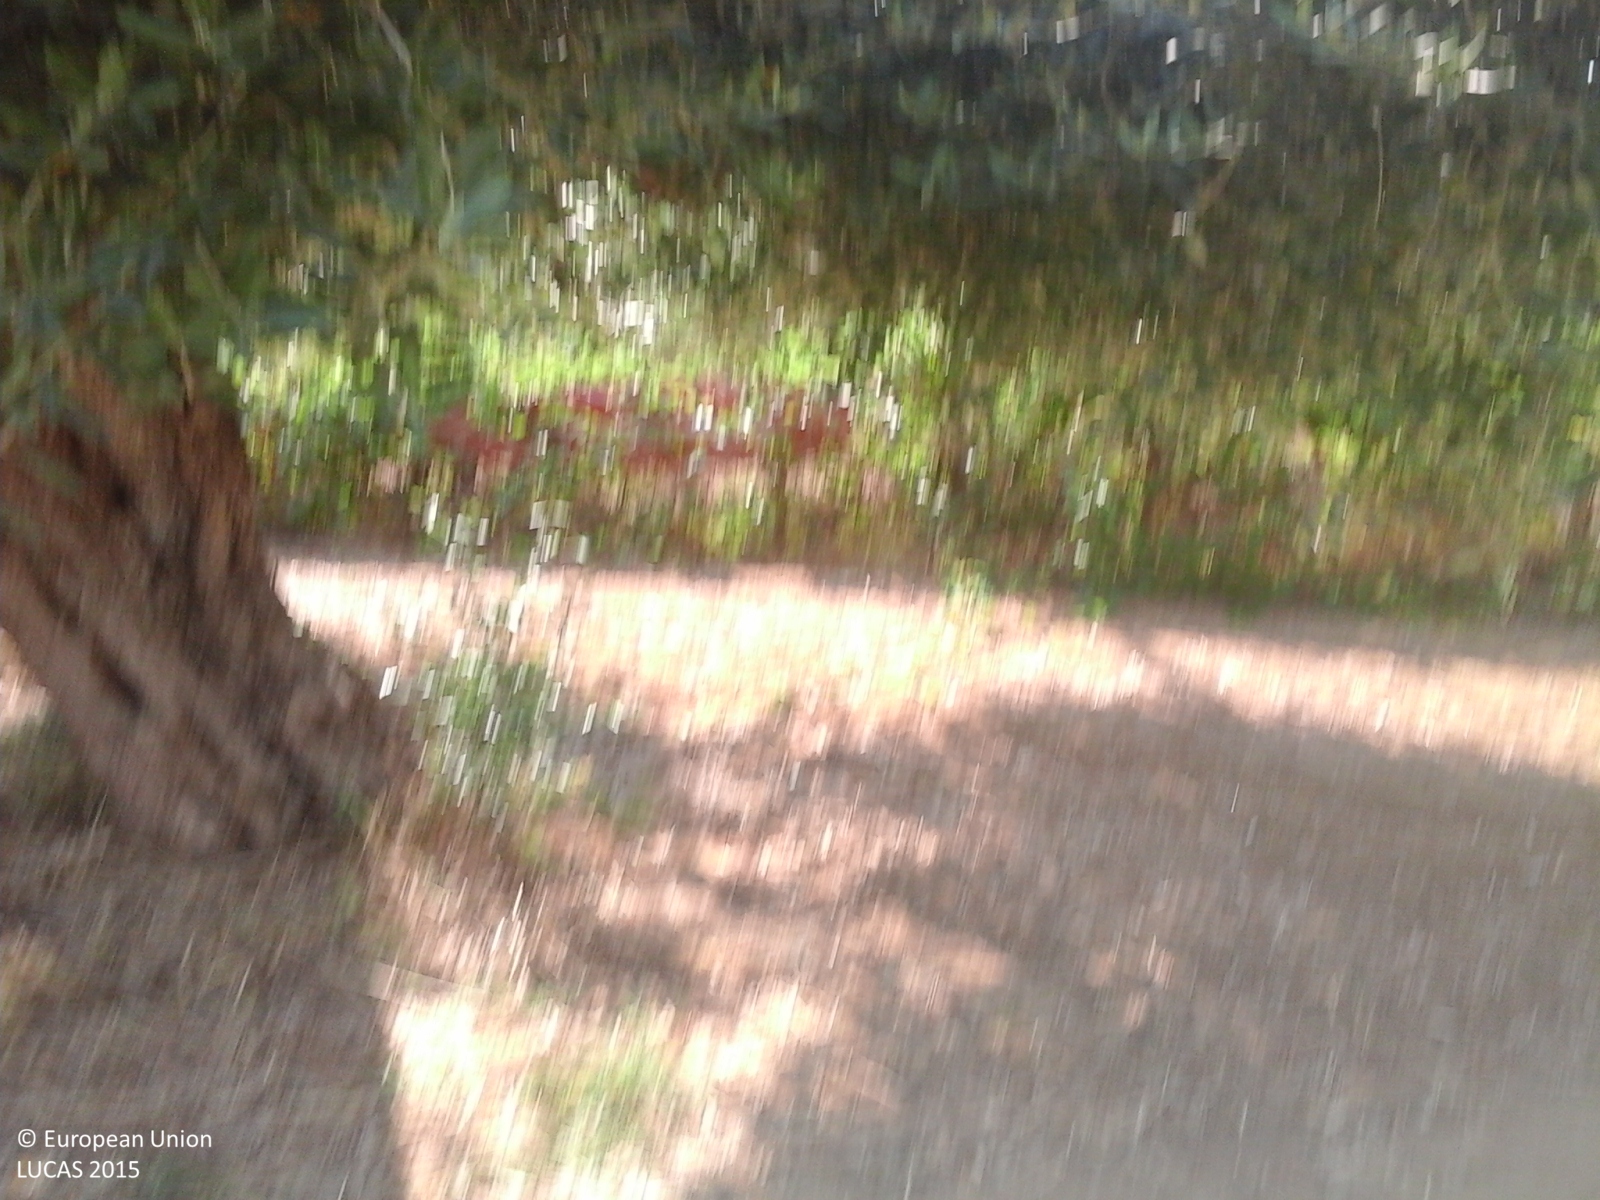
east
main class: Grassland
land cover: Grassland with sparse tree/shrub cover
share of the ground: > 75 %
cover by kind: herbaceous plants 95 %, broadleaved forest trees 5 %
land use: Agriculture (excluding fallow land and kitchen gardens)
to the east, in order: Tracks; Grassland with sparse tree/shrub cover; Fences; Olive groves; Abandoned hedges; Fences; Spontaneously vegetated surfaces; Paved roads, cycling and walking lanes; Fences; Olive groves; Vineyards; Fences; Olive groves; Fences; Spontaneously vegetated surfaces
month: July
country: IT
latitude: 37.0474
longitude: 14.3619
